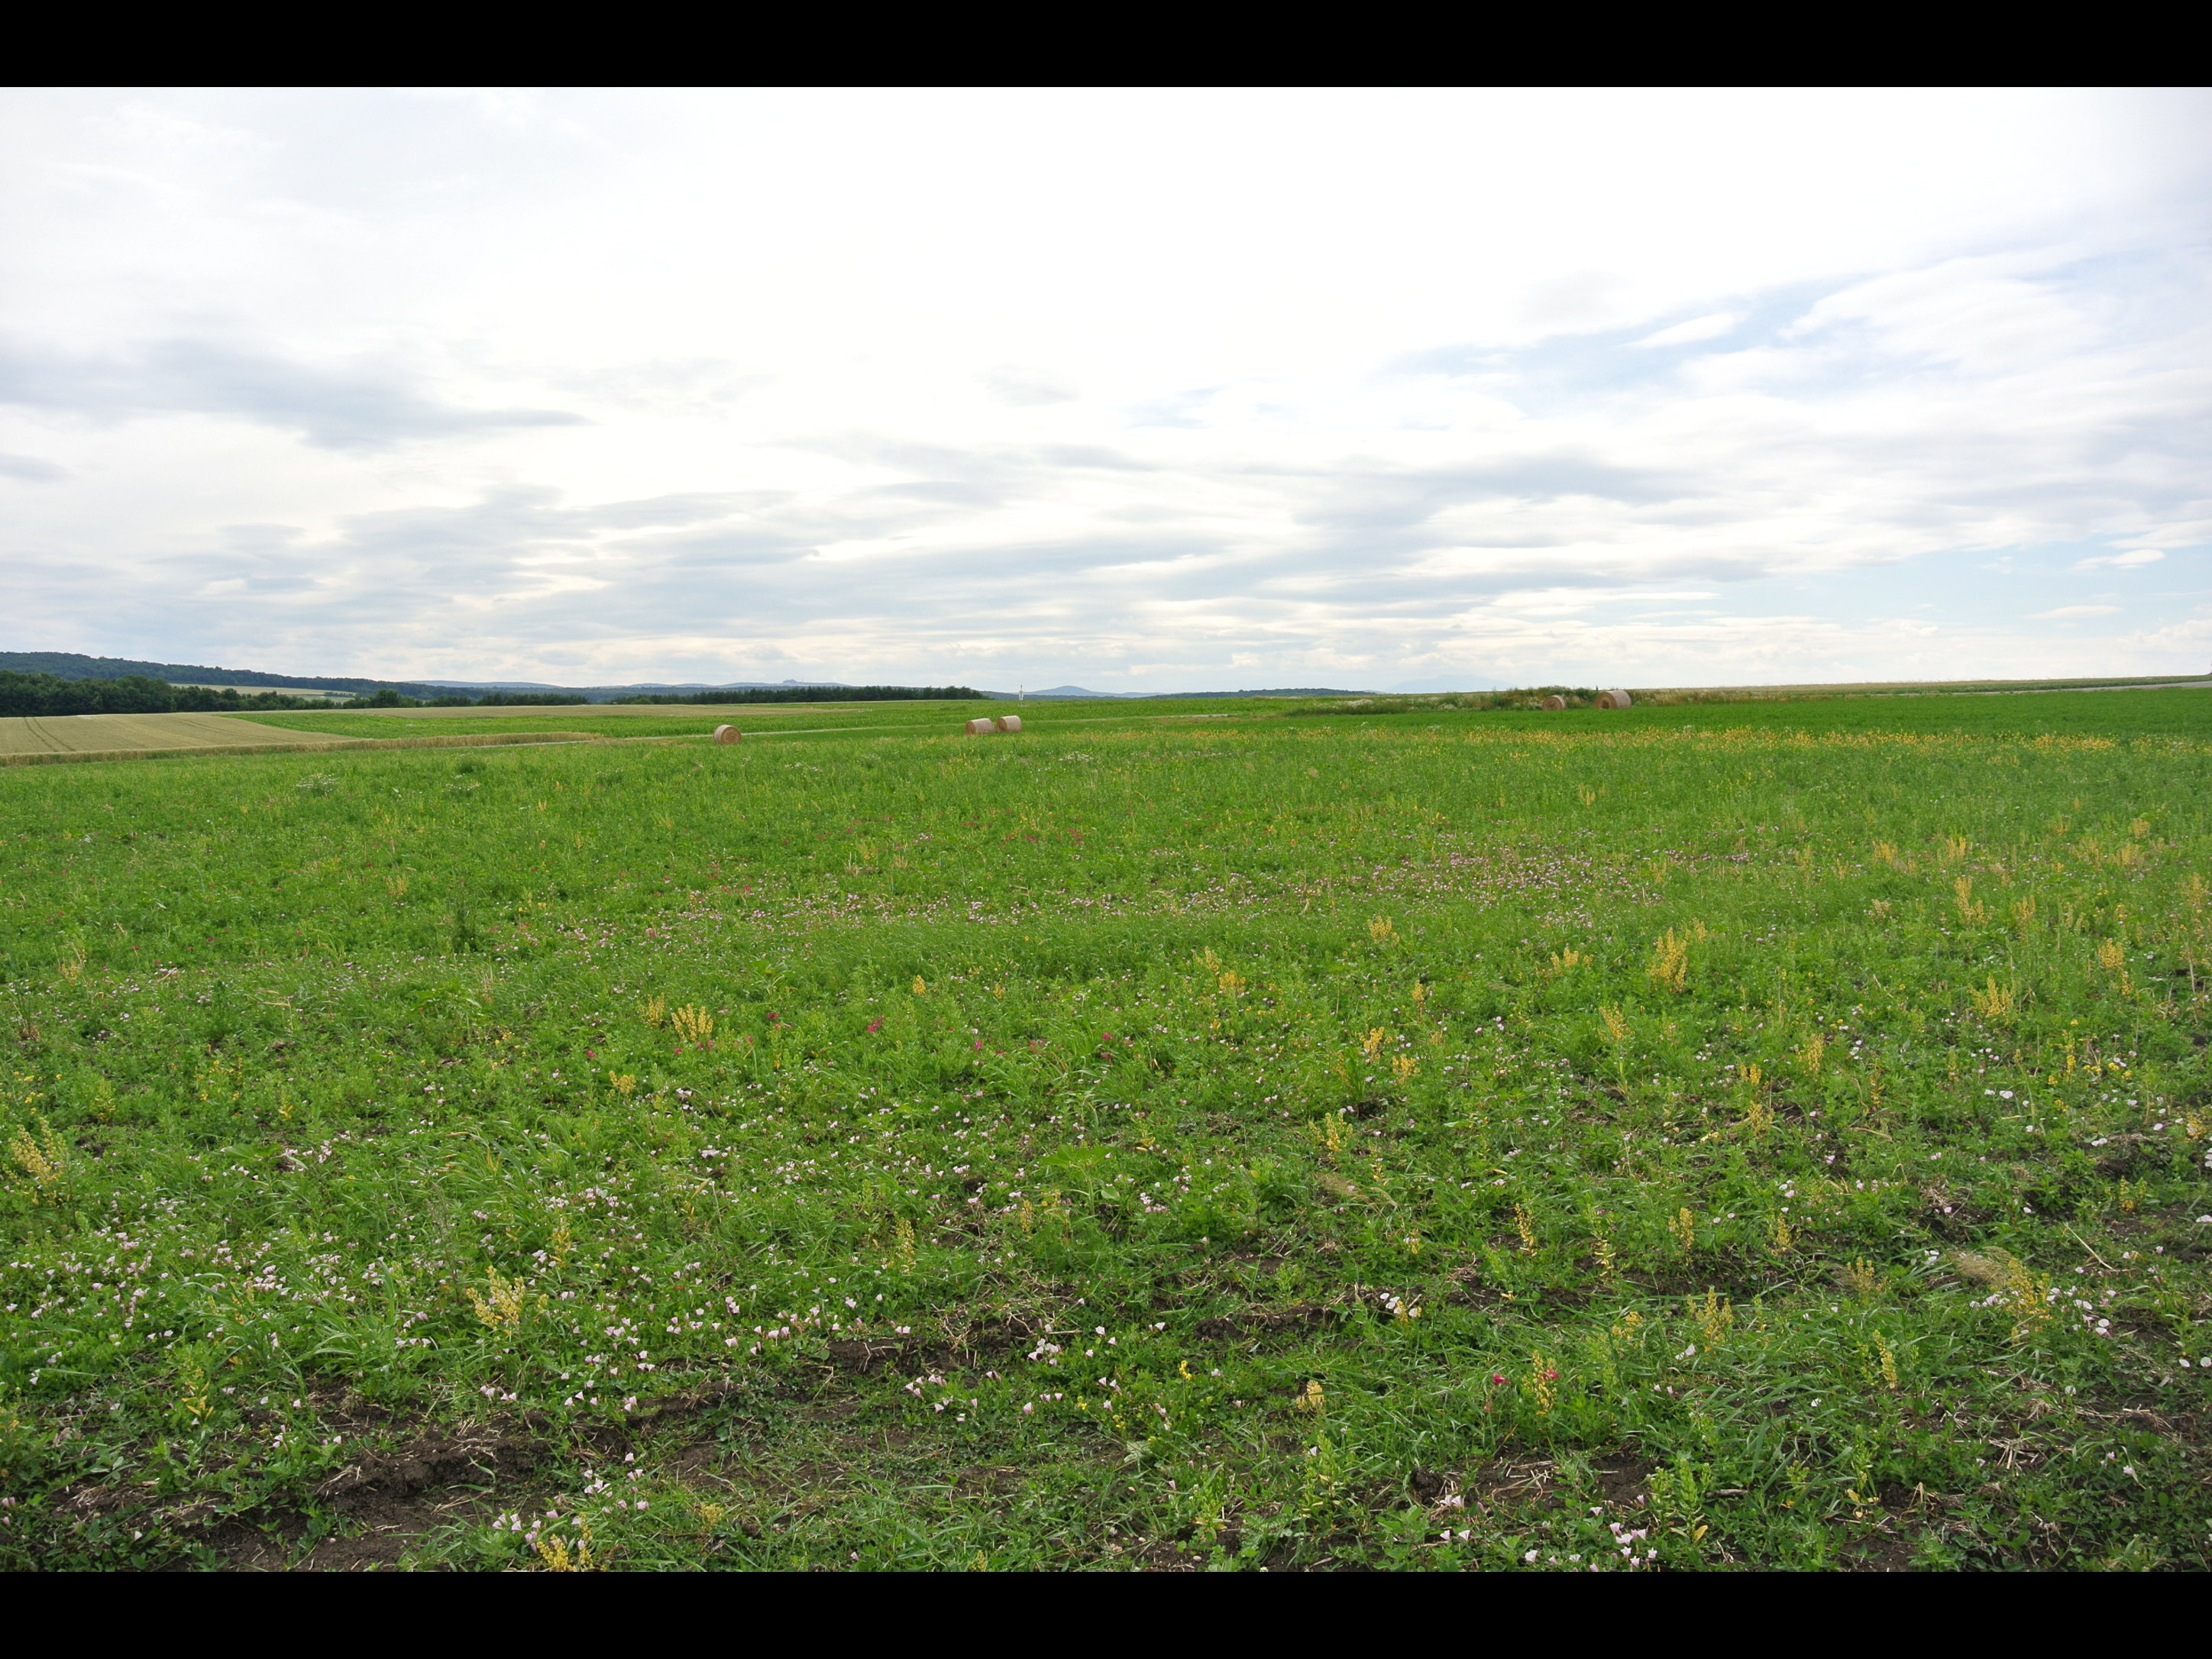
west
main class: Cropland
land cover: Other leguminous and mixtures for fodder
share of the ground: > 75 %
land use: Agriculture (excluding fallow land and kitchen gardens)
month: June
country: AT
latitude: 47.7413
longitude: 16.5259
